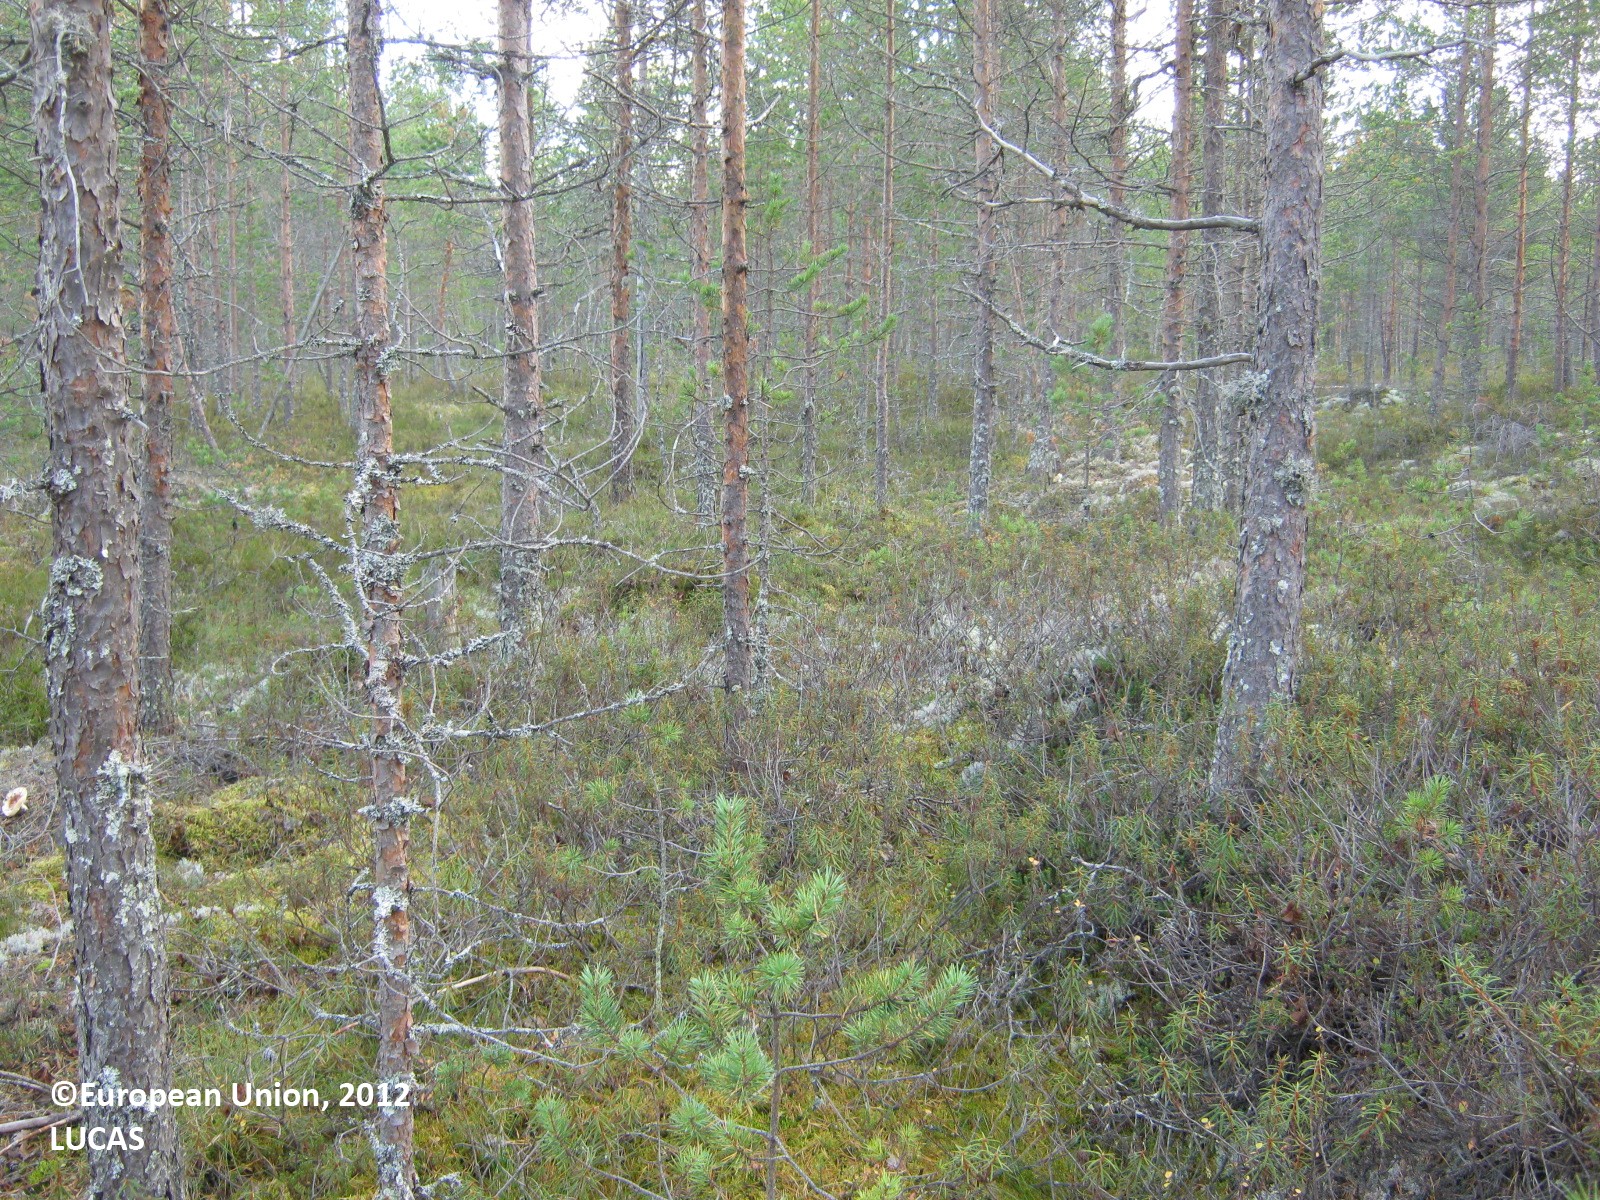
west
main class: Woodland
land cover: Pine dominated coniferous woodland
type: boreal forest
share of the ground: > 75 %
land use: Forestry
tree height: > 5 m
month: September
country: FI
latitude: 63.4635
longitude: 25.8593
